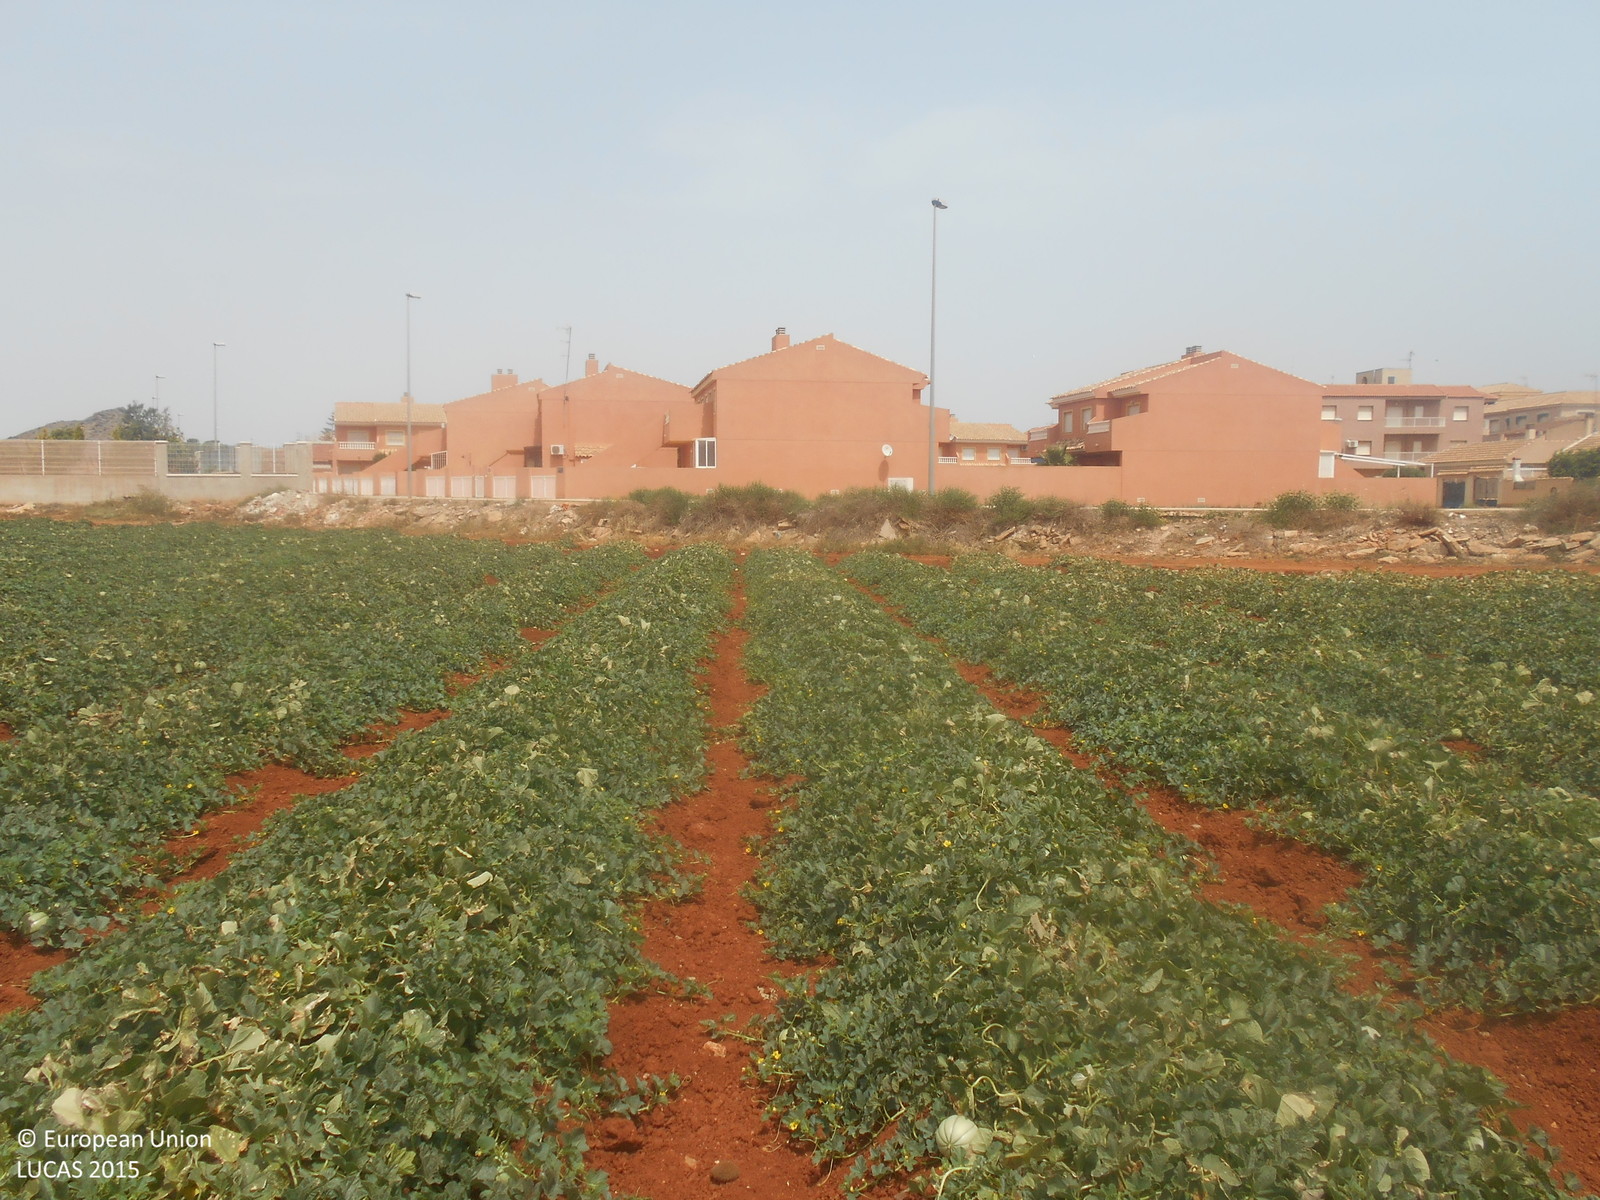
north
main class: Cropland
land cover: Other fresh vegetables
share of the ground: 50 - 75 %
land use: Agriculture (excluding fallow land and kitchen gardens)
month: May
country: ES
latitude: 37.6757
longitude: -0.8294
